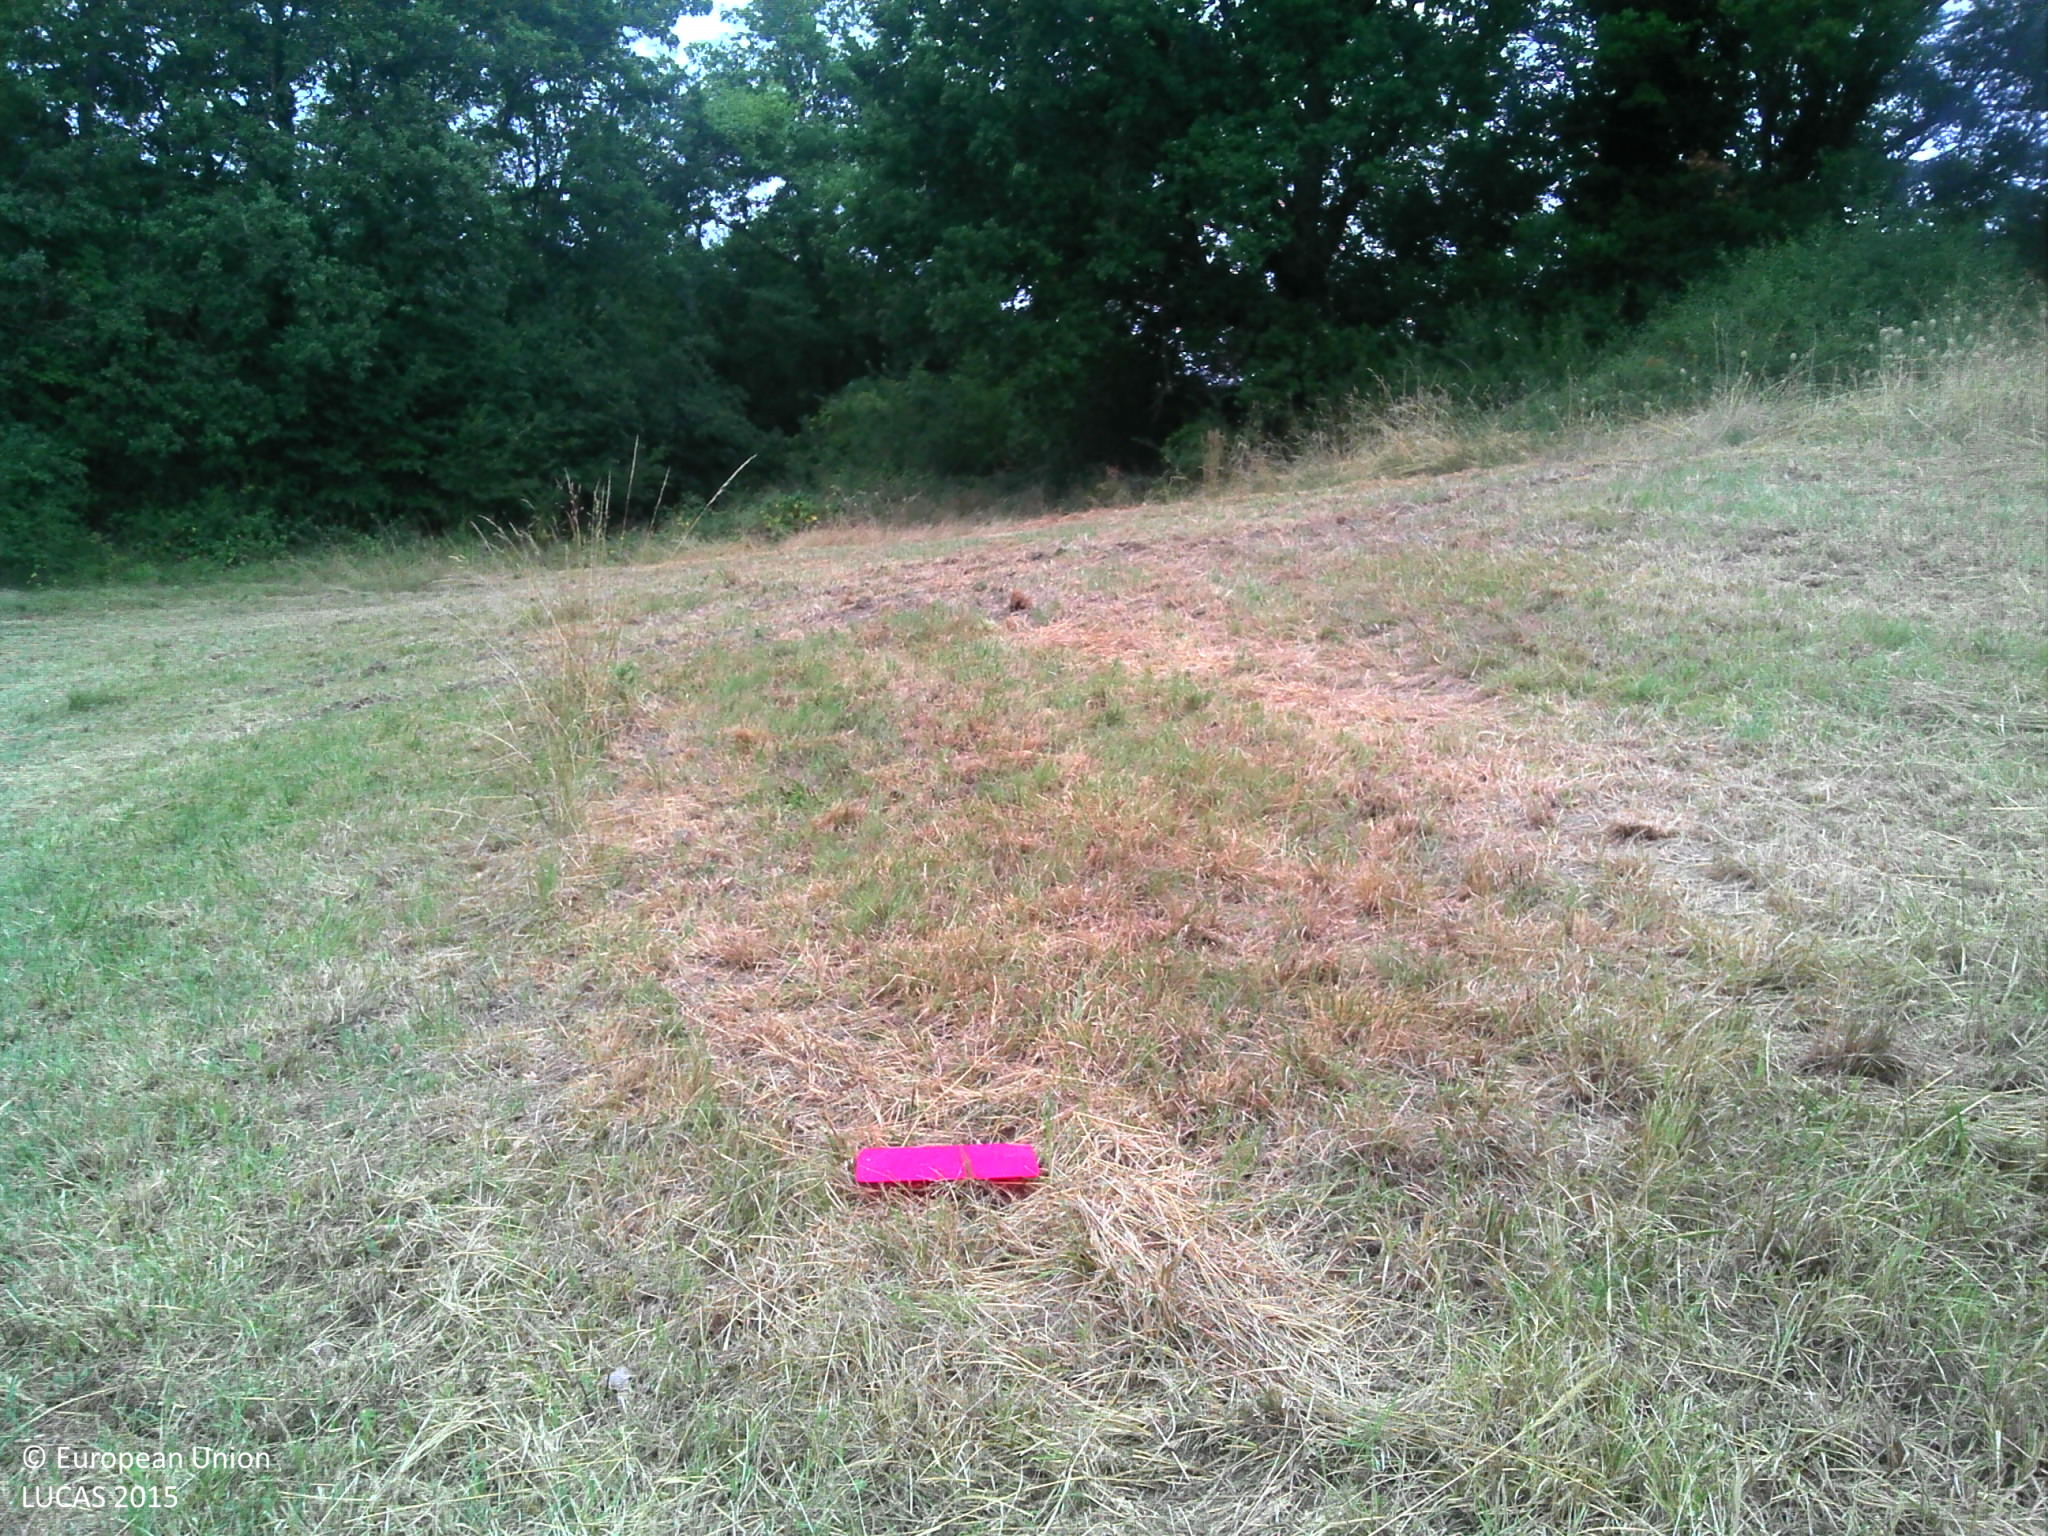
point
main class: Grassland
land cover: Grassland without tree/shrub cover
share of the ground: > 75 %
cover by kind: herbaceous plants 100 %
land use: Agriculture (excluding fallow land and kitchen gardens)
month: July
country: FR
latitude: 44.2082
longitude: 0.9485
